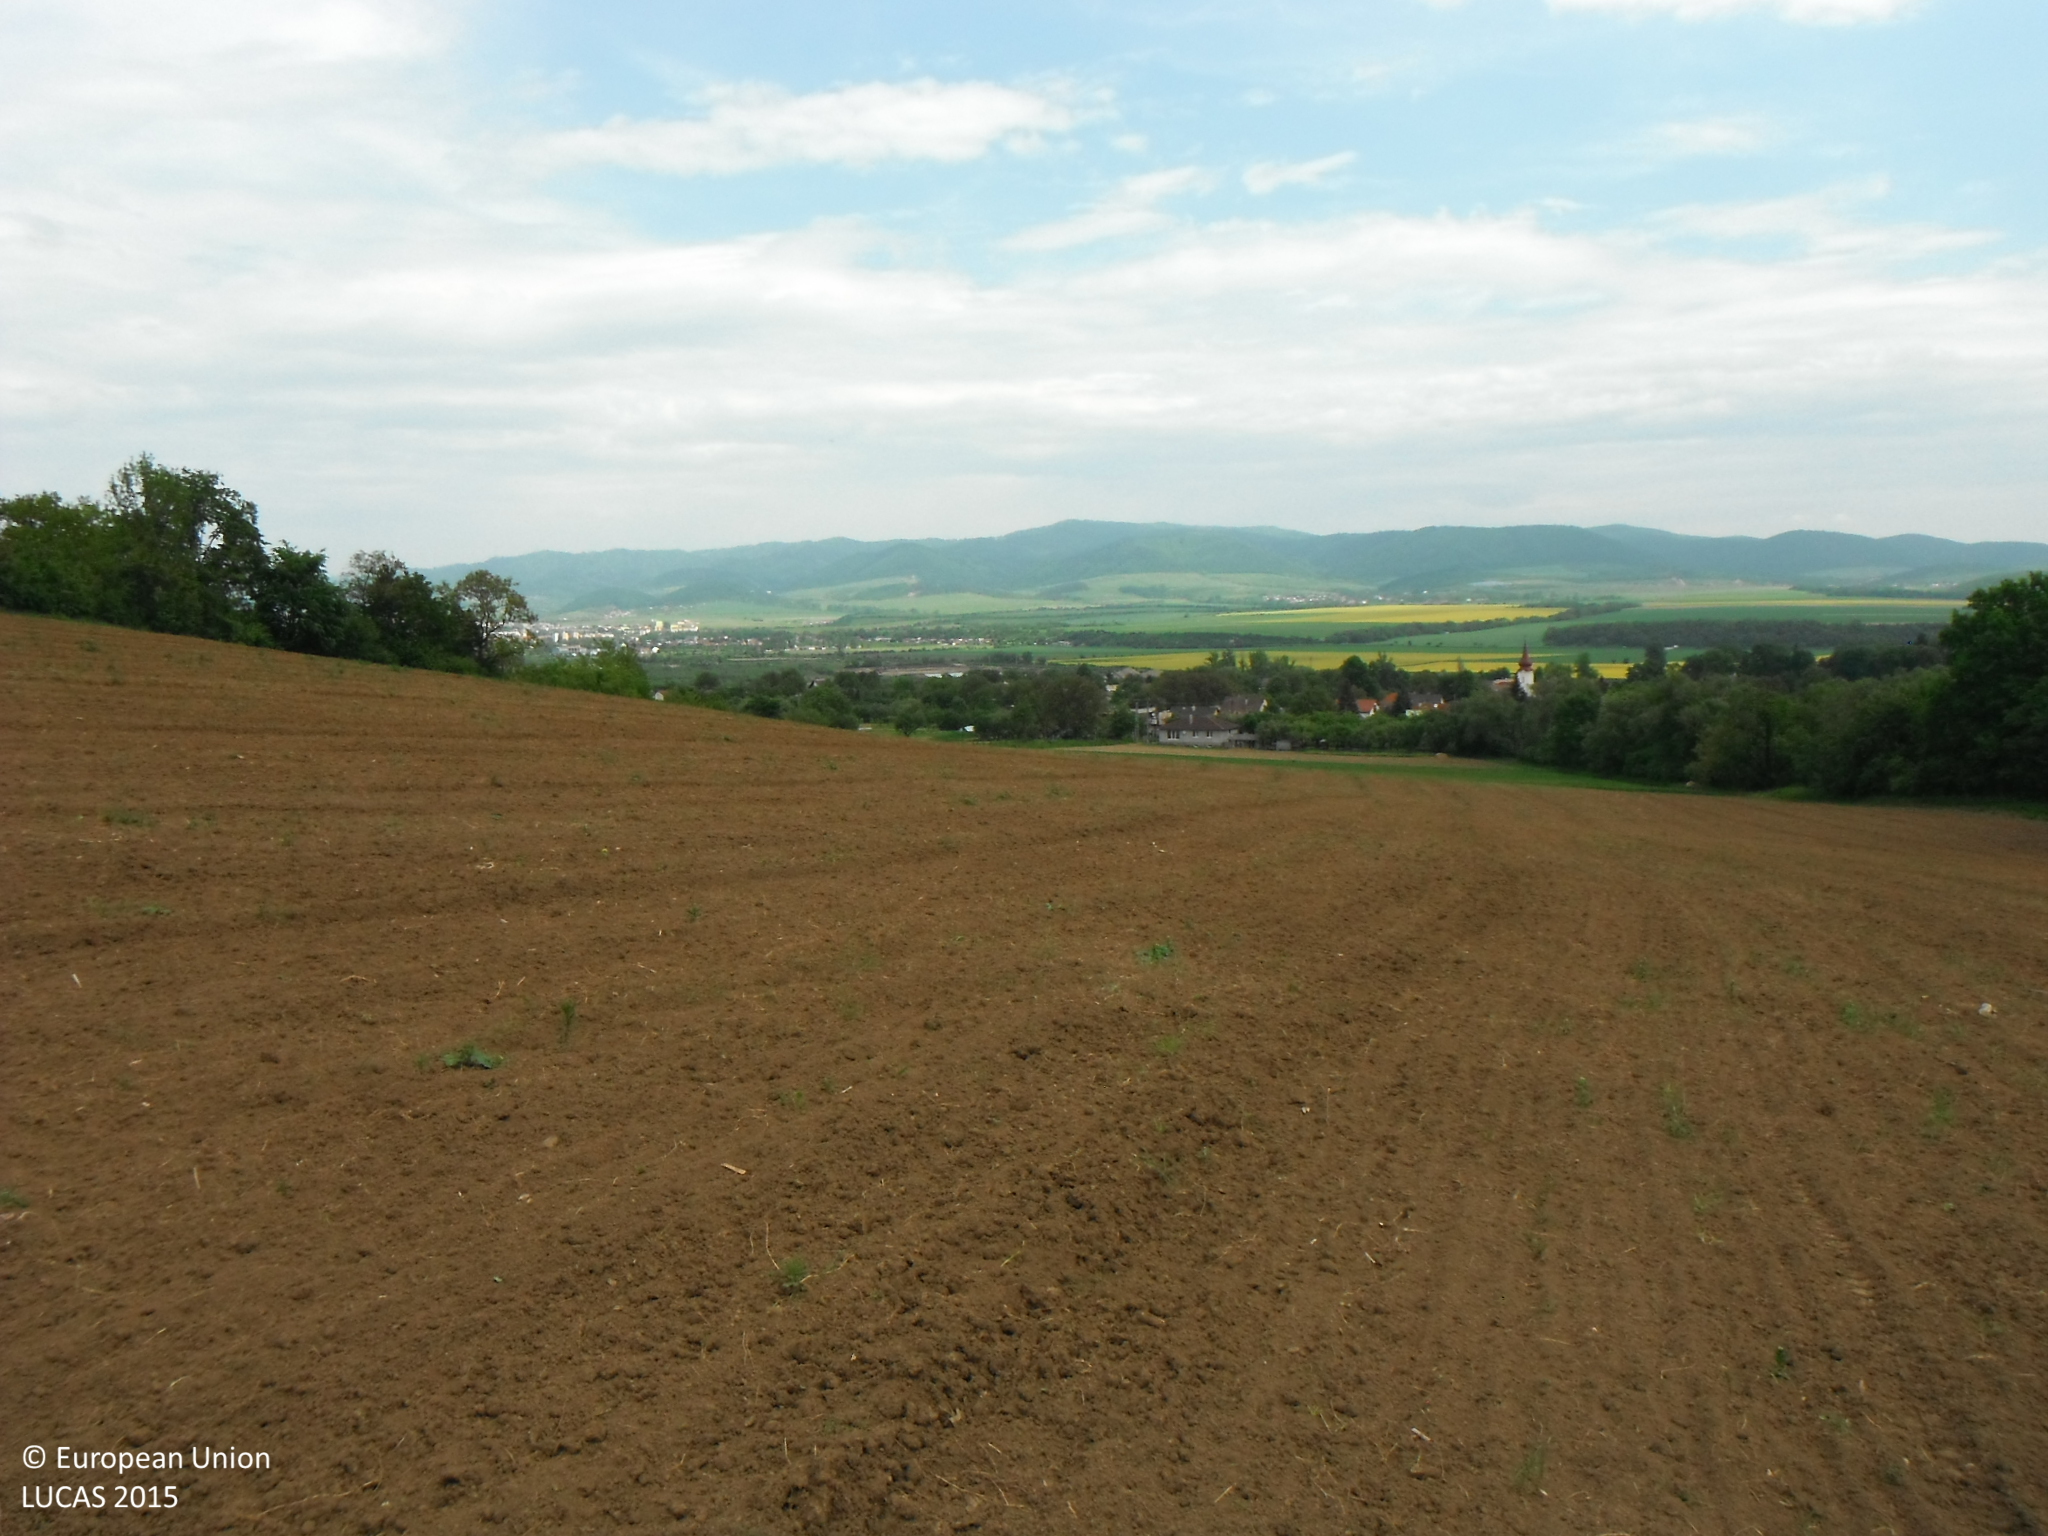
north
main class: Cropland
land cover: Other cereals
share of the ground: < 10 %
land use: Agriculture (excluding fallow land and kitchen gardens)
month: May
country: SK
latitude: 49.0579
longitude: 21.1145
